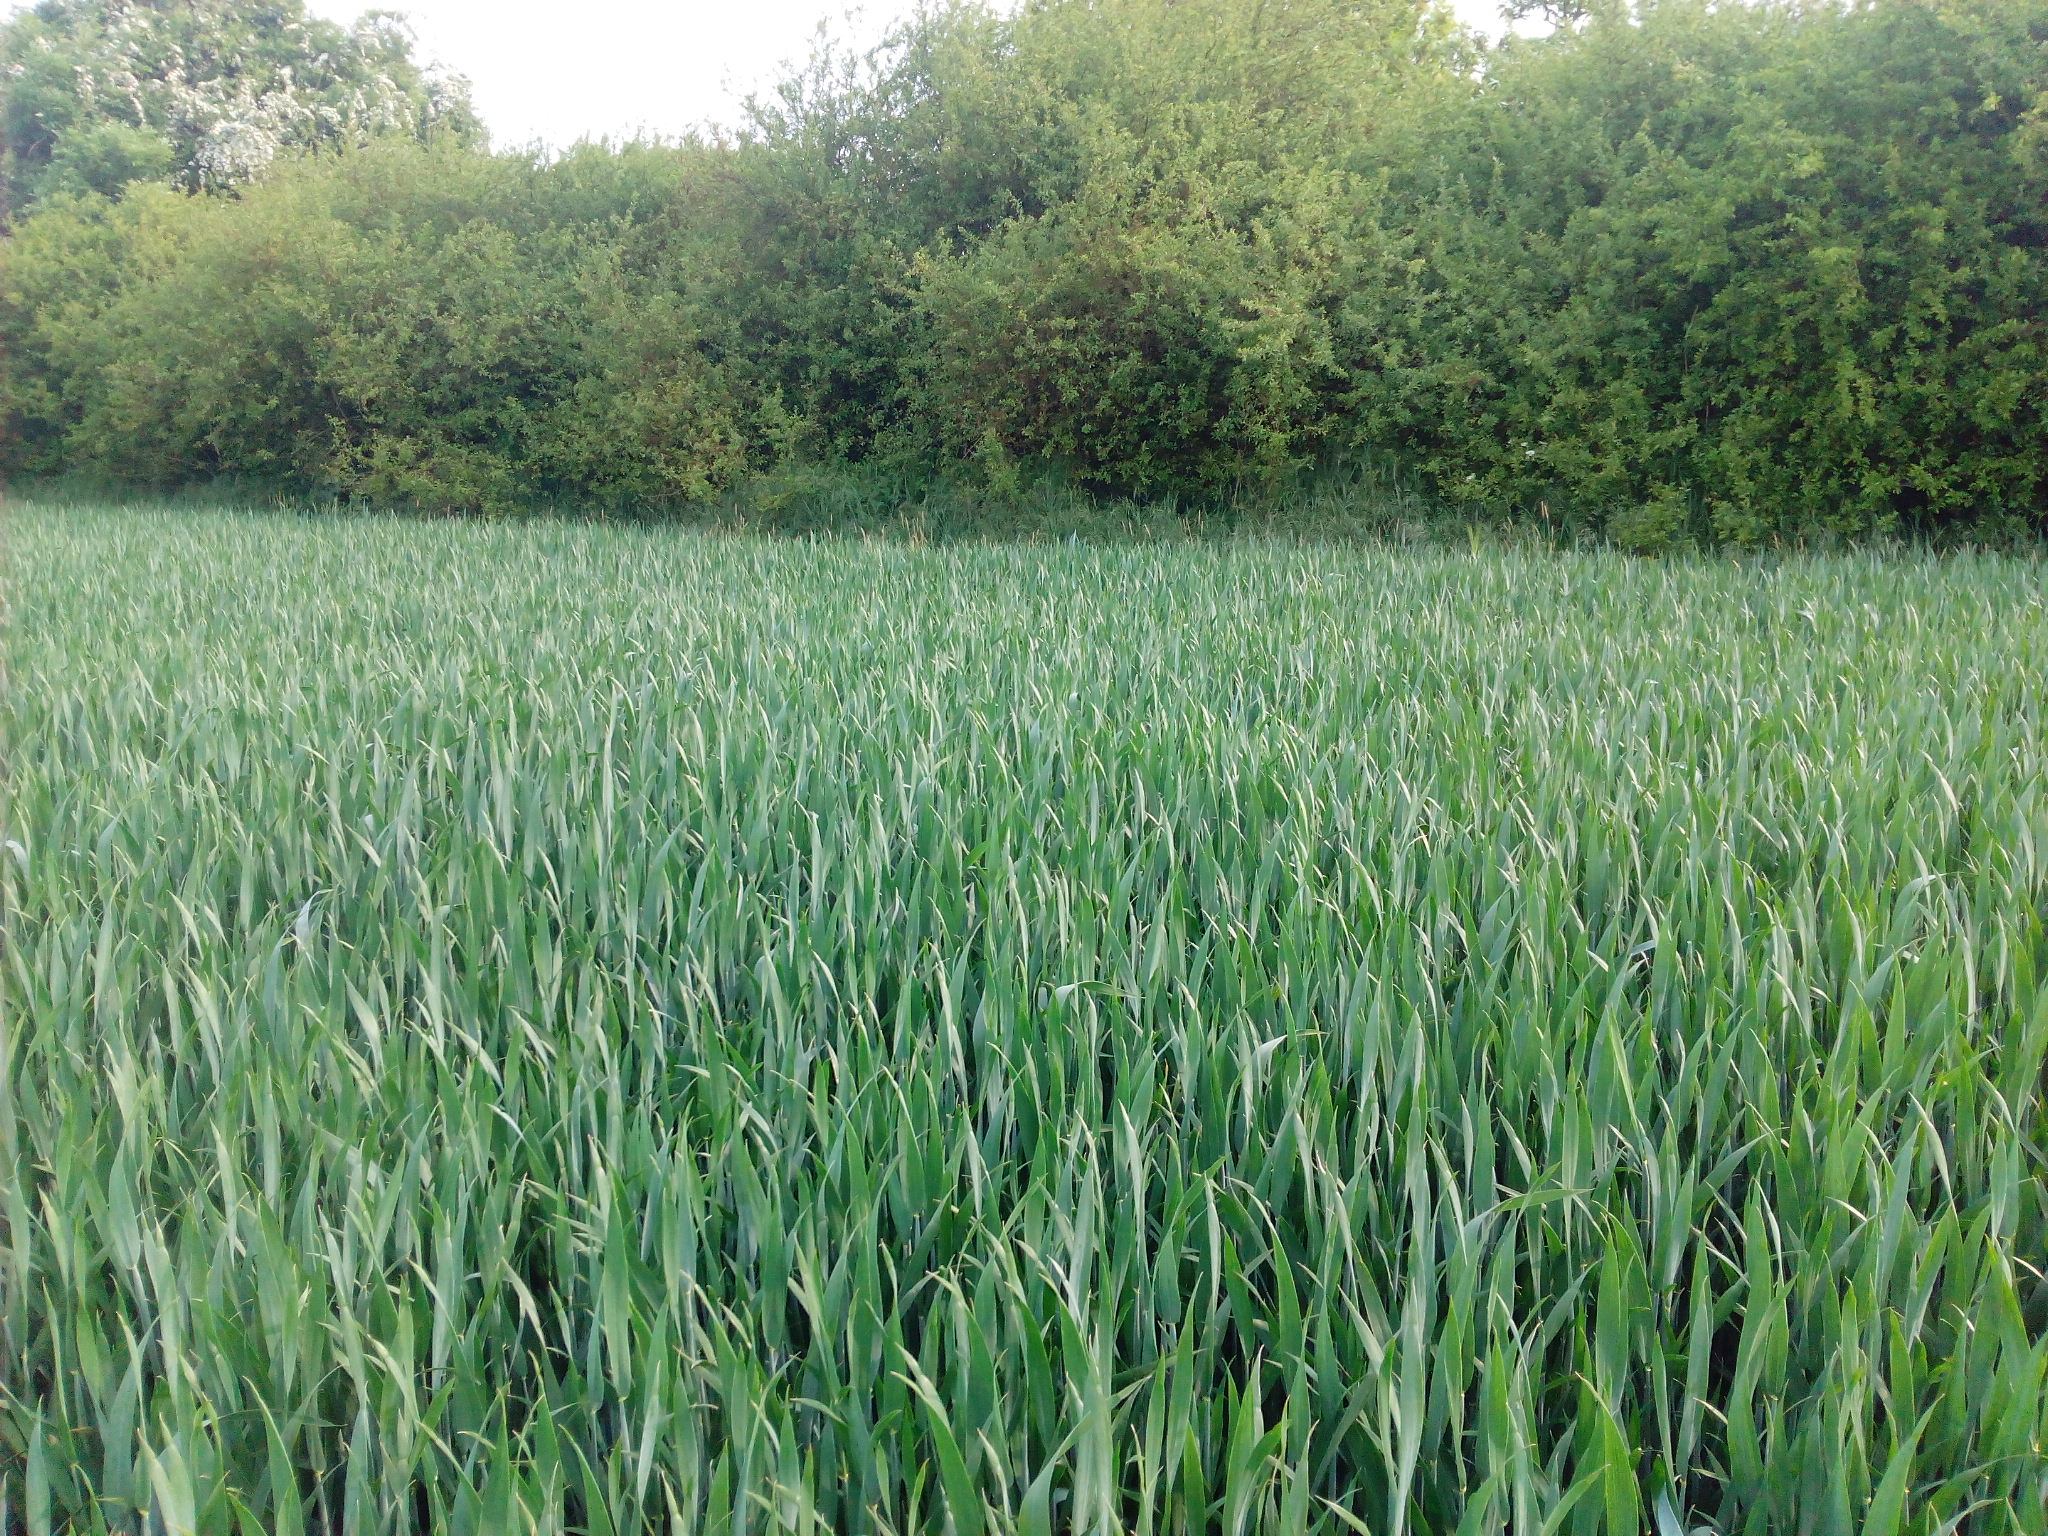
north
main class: Cropland
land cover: Common wheat
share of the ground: > 75 %
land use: Agriculture (excluding fallow land and kitchen gardens)
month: May
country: DE
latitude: 53.8077
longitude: 13.2644
